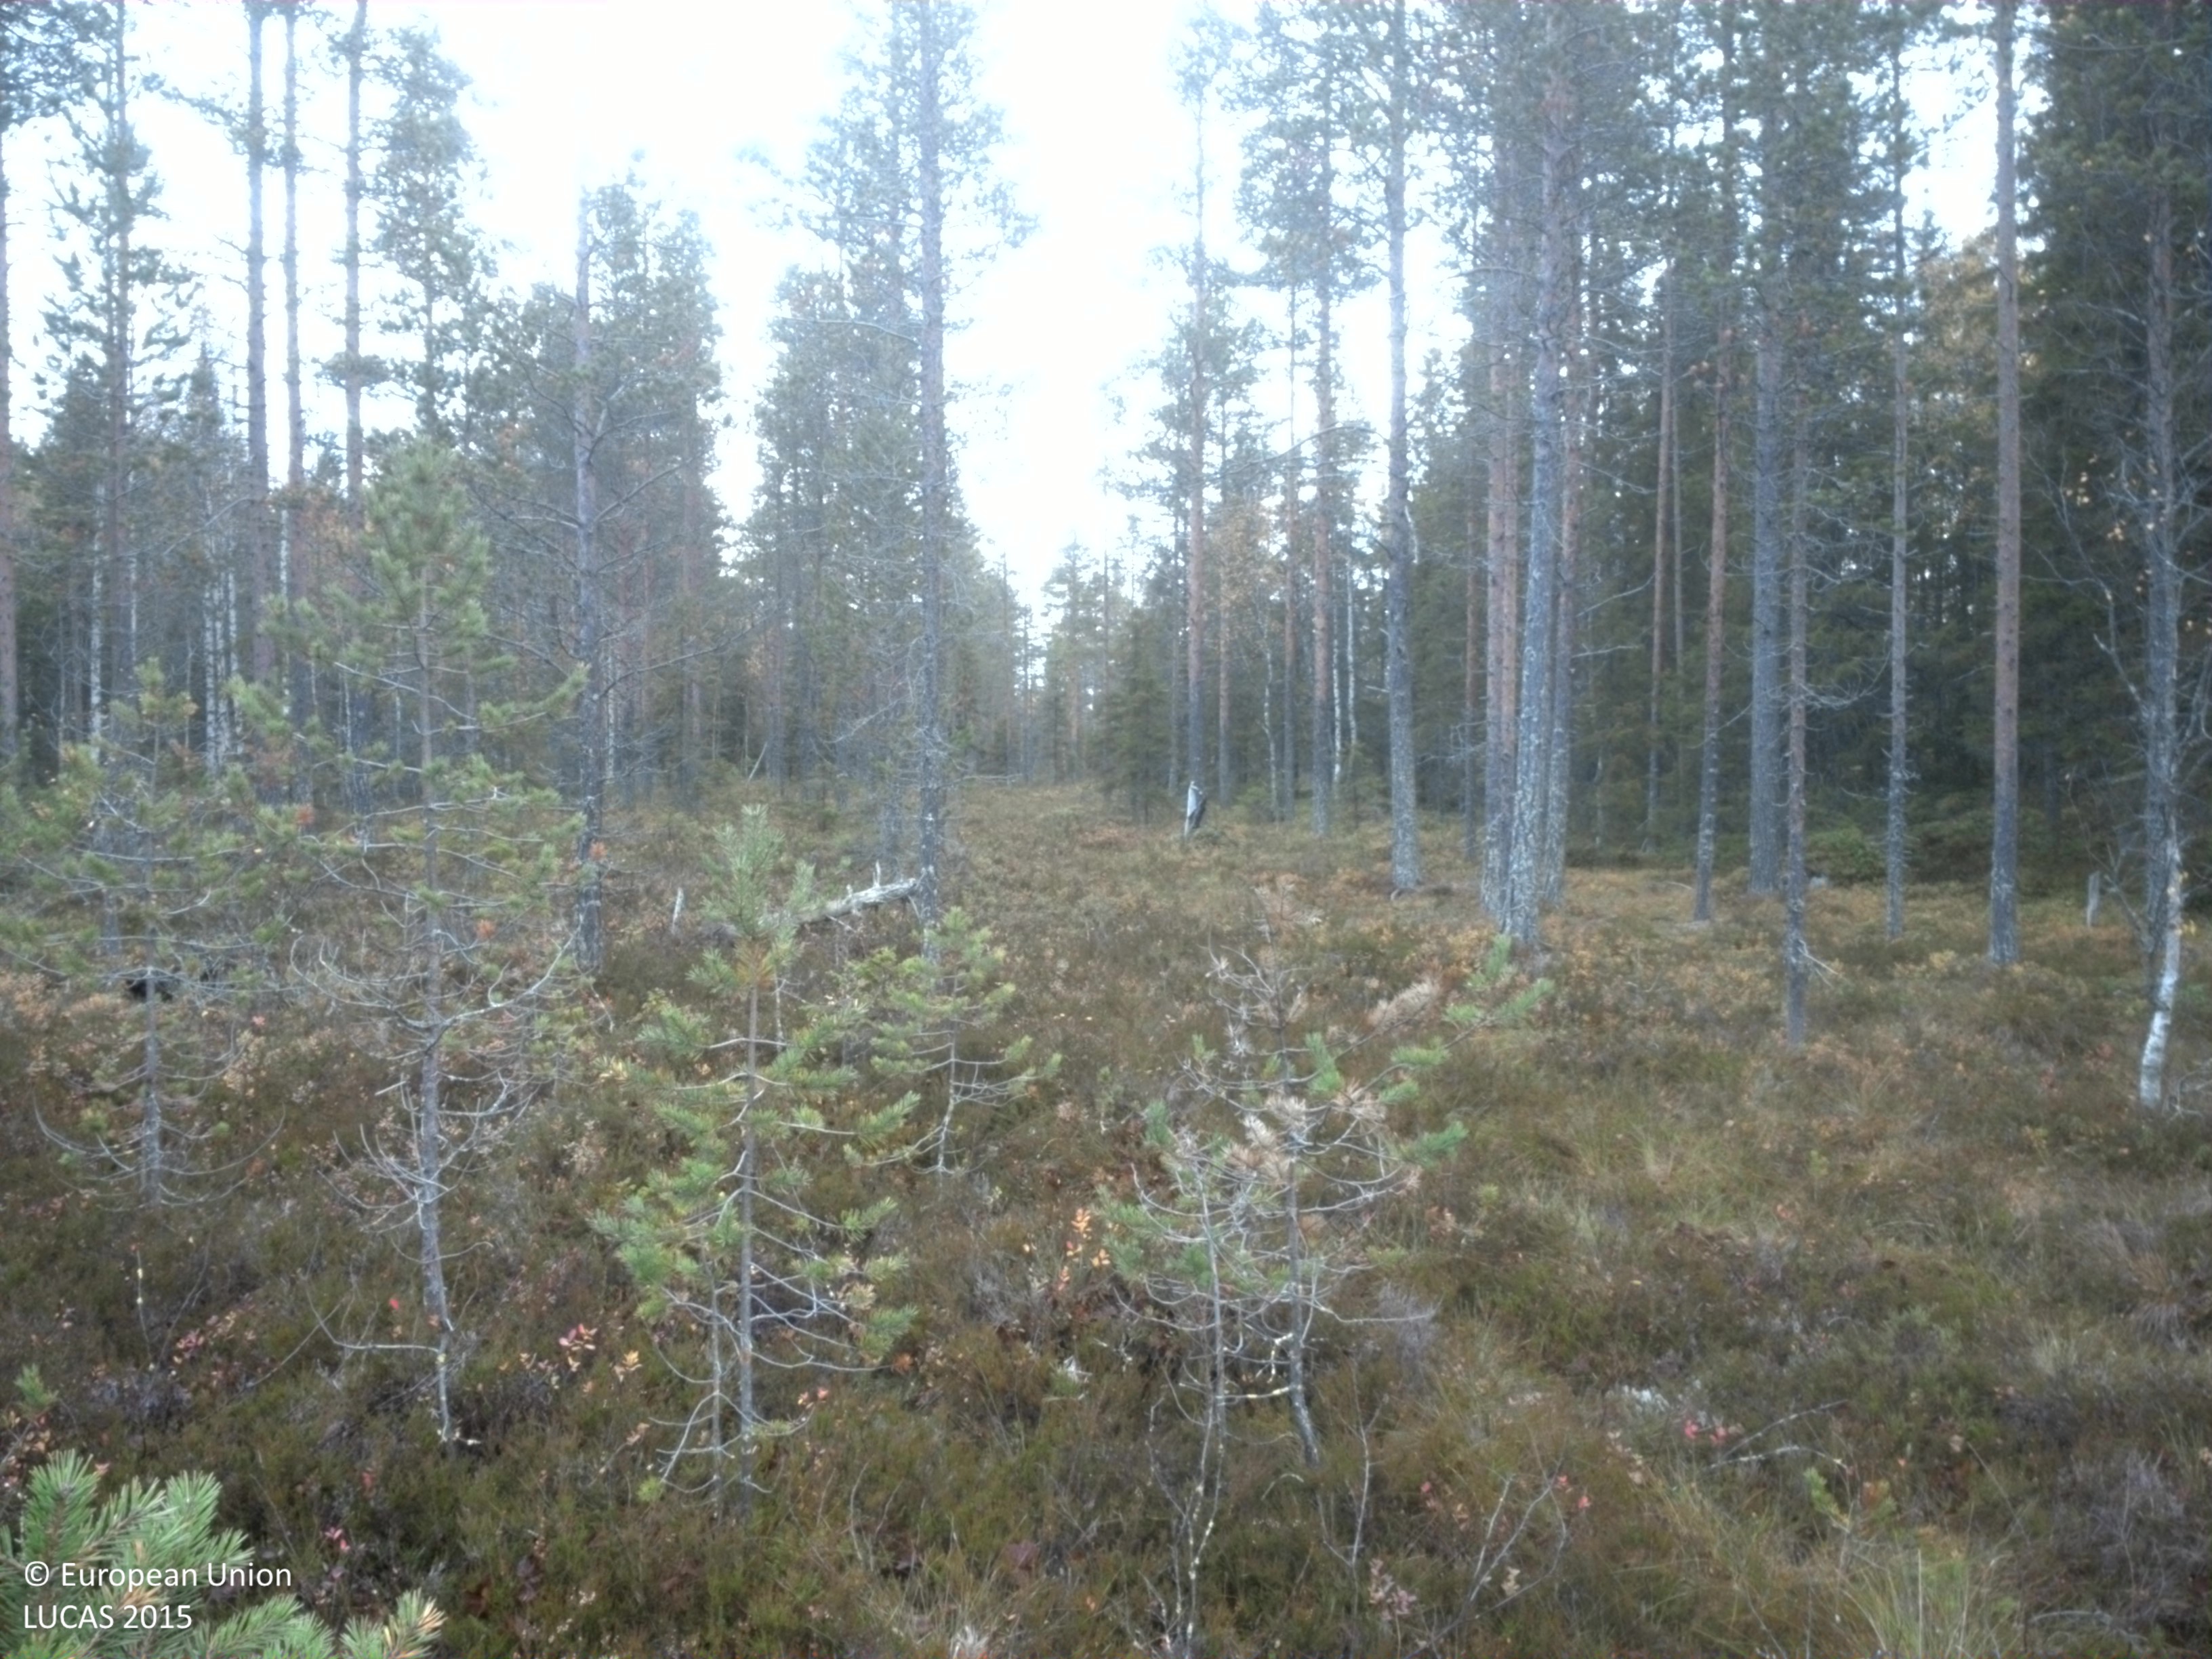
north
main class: Woodland
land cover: Pine dominated coniferous woodland
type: boreal forest
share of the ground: 25 - 50 %
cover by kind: coniferous forest trees 40 %, shrubs 30 %, lichens and mosses 25 %, herbaceous plants 5 %
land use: Semi-natural and natural areas not in use
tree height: > 5 m
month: September
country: SE
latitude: 64.2141
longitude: 19.9278
